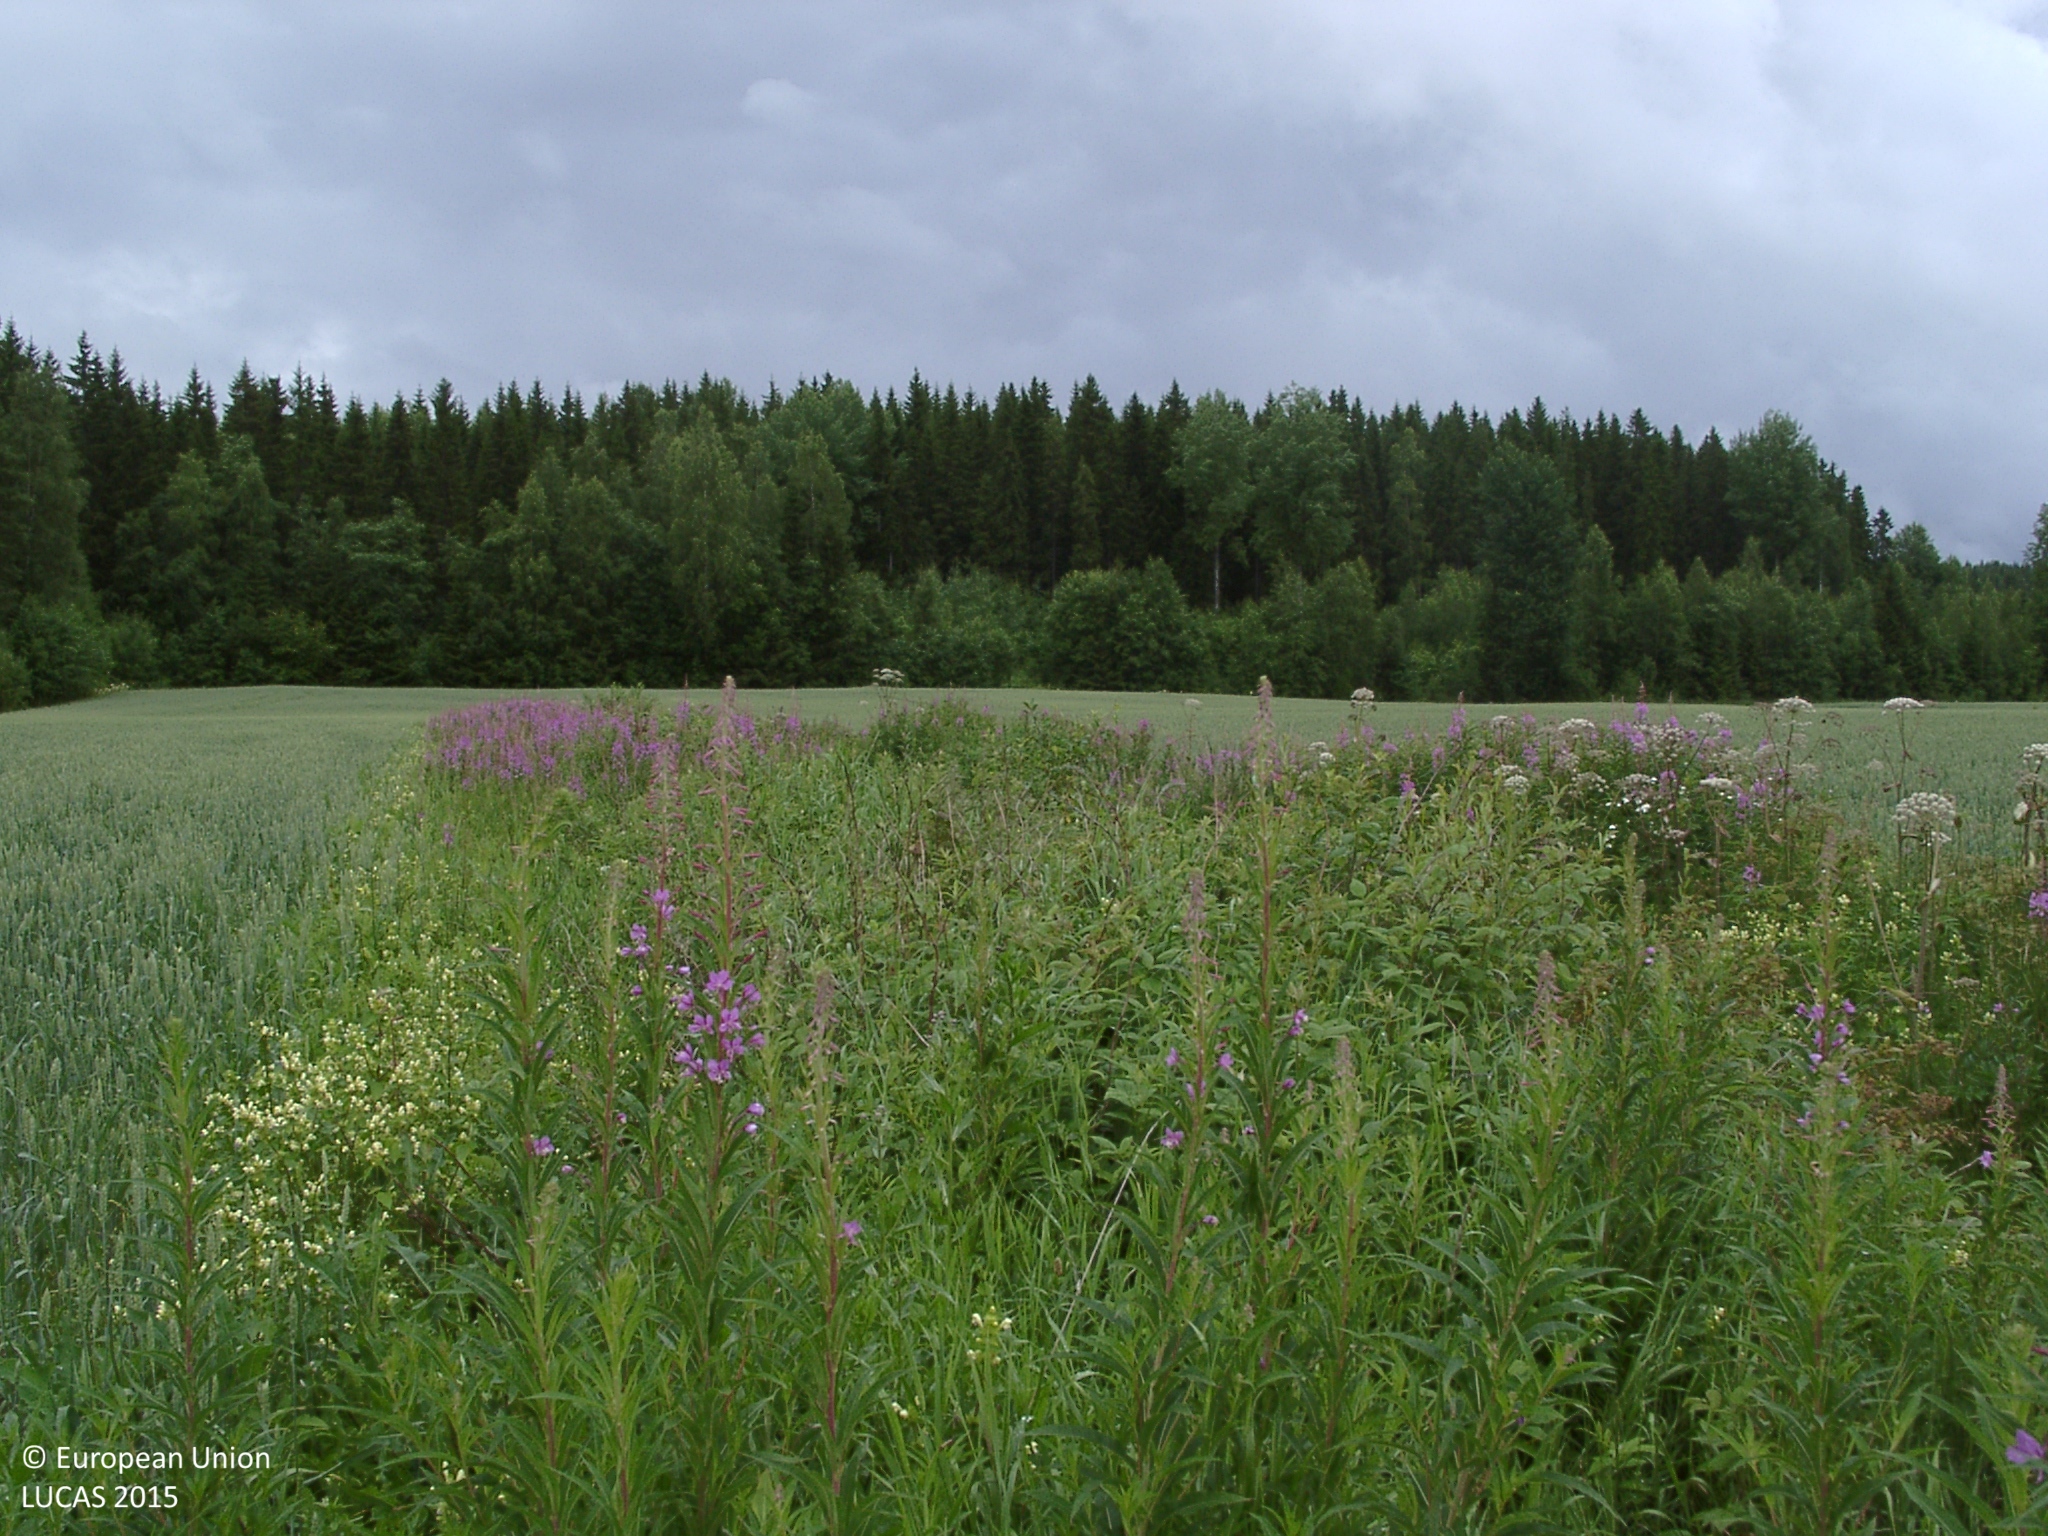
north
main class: Cropland
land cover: Common wheat
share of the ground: > 75 %
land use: Agriculture (excluding fallow land and kitchen gardens)
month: July
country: FI
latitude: 61.9654
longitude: 25.3520
